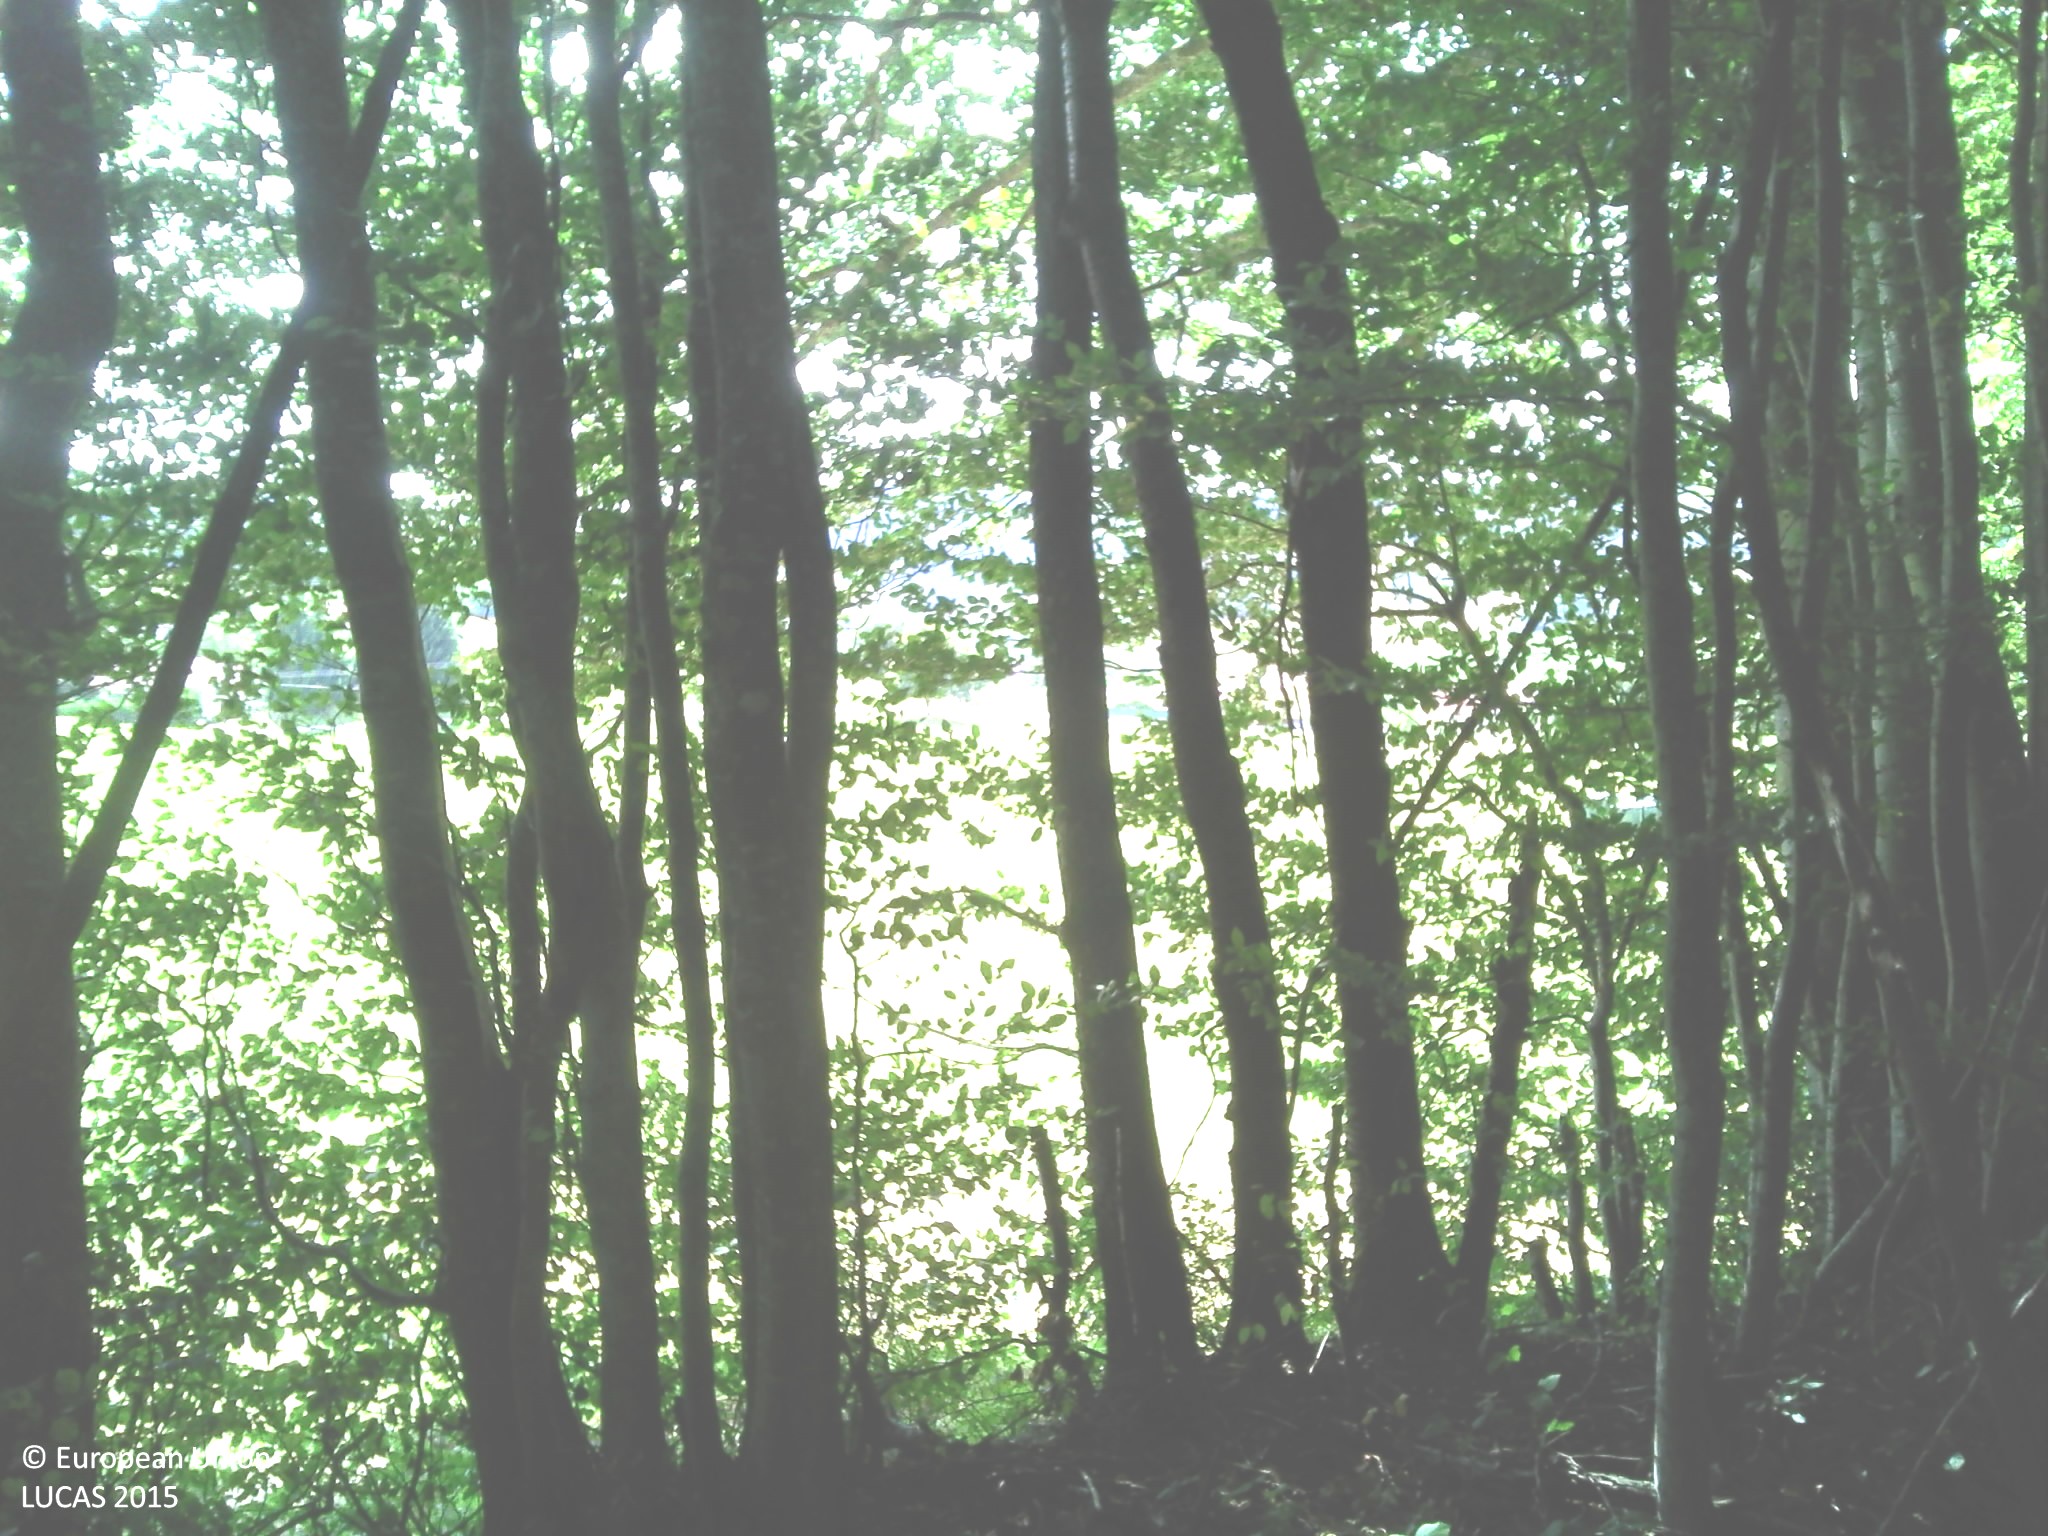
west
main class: Woodland
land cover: Broadleaved woodland
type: thermophilous deciduous forest
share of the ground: > 75 %
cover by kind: broadleaved forest trees 90 %, herbaceous plants 5 %, consolidated bare surface 5 %
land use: Forestry
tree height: > 5 m
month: July
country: FR
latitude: 45.4676
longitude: 5.6177
